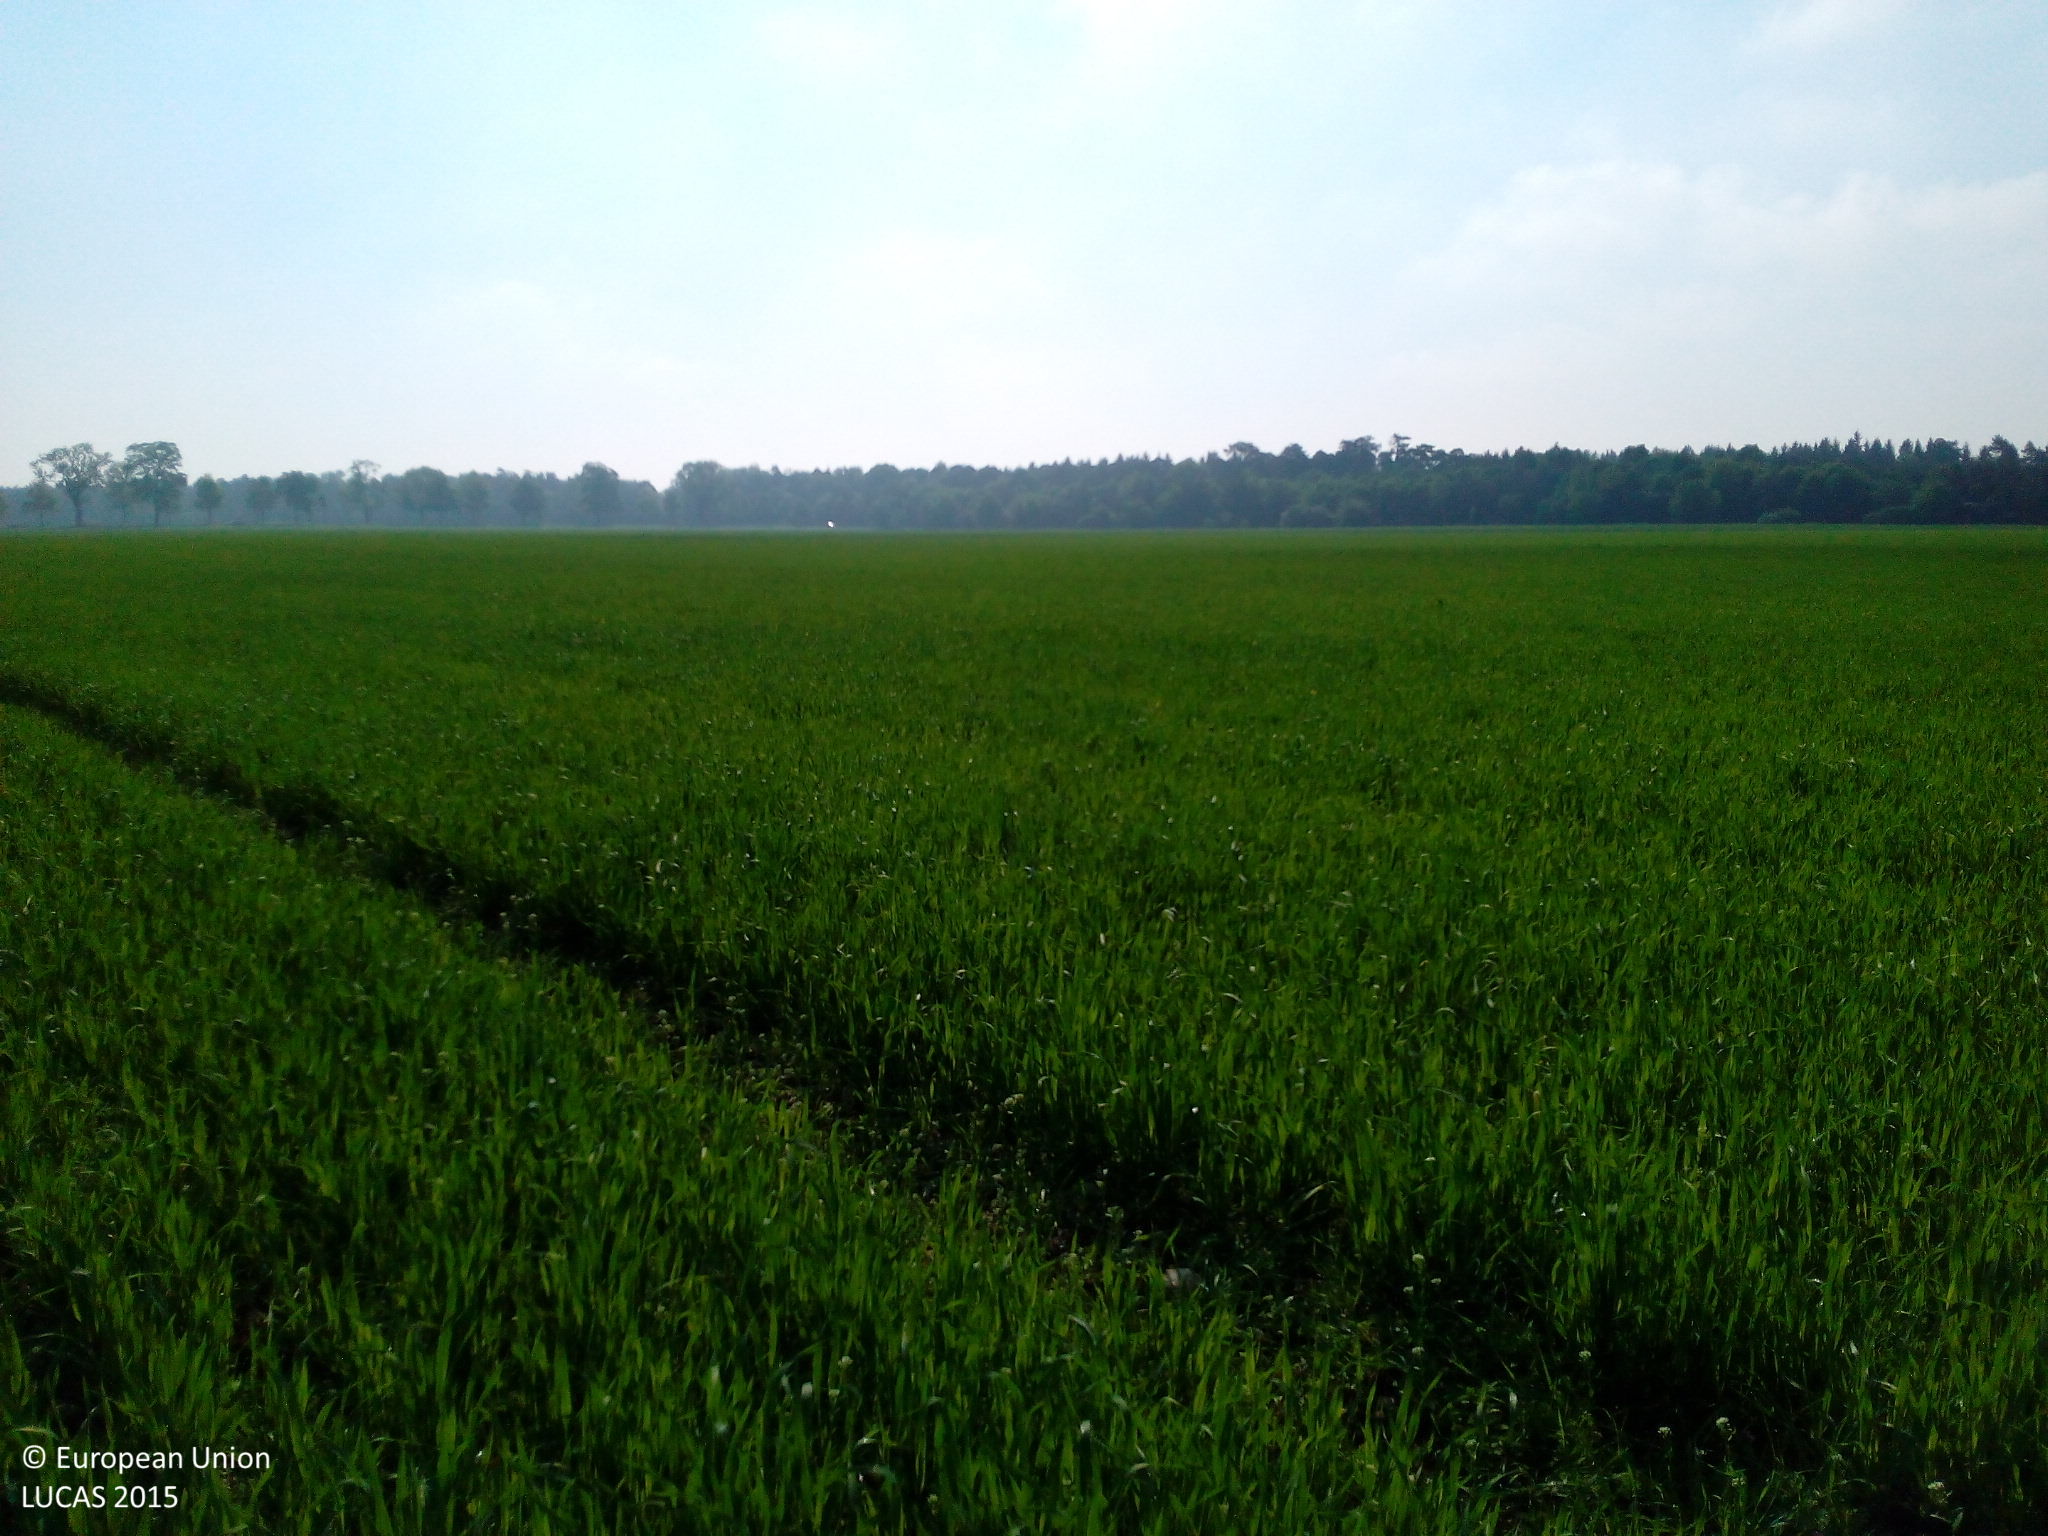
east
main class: Cropland
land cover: Common wheat
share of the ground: > 75 %
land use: Agriculture (excluding fallow land and kitchen gardens)
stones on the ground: 25 - 50 %
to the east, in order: Common wheat
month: May
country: DE
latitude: 48.2303
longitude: 11.5742
